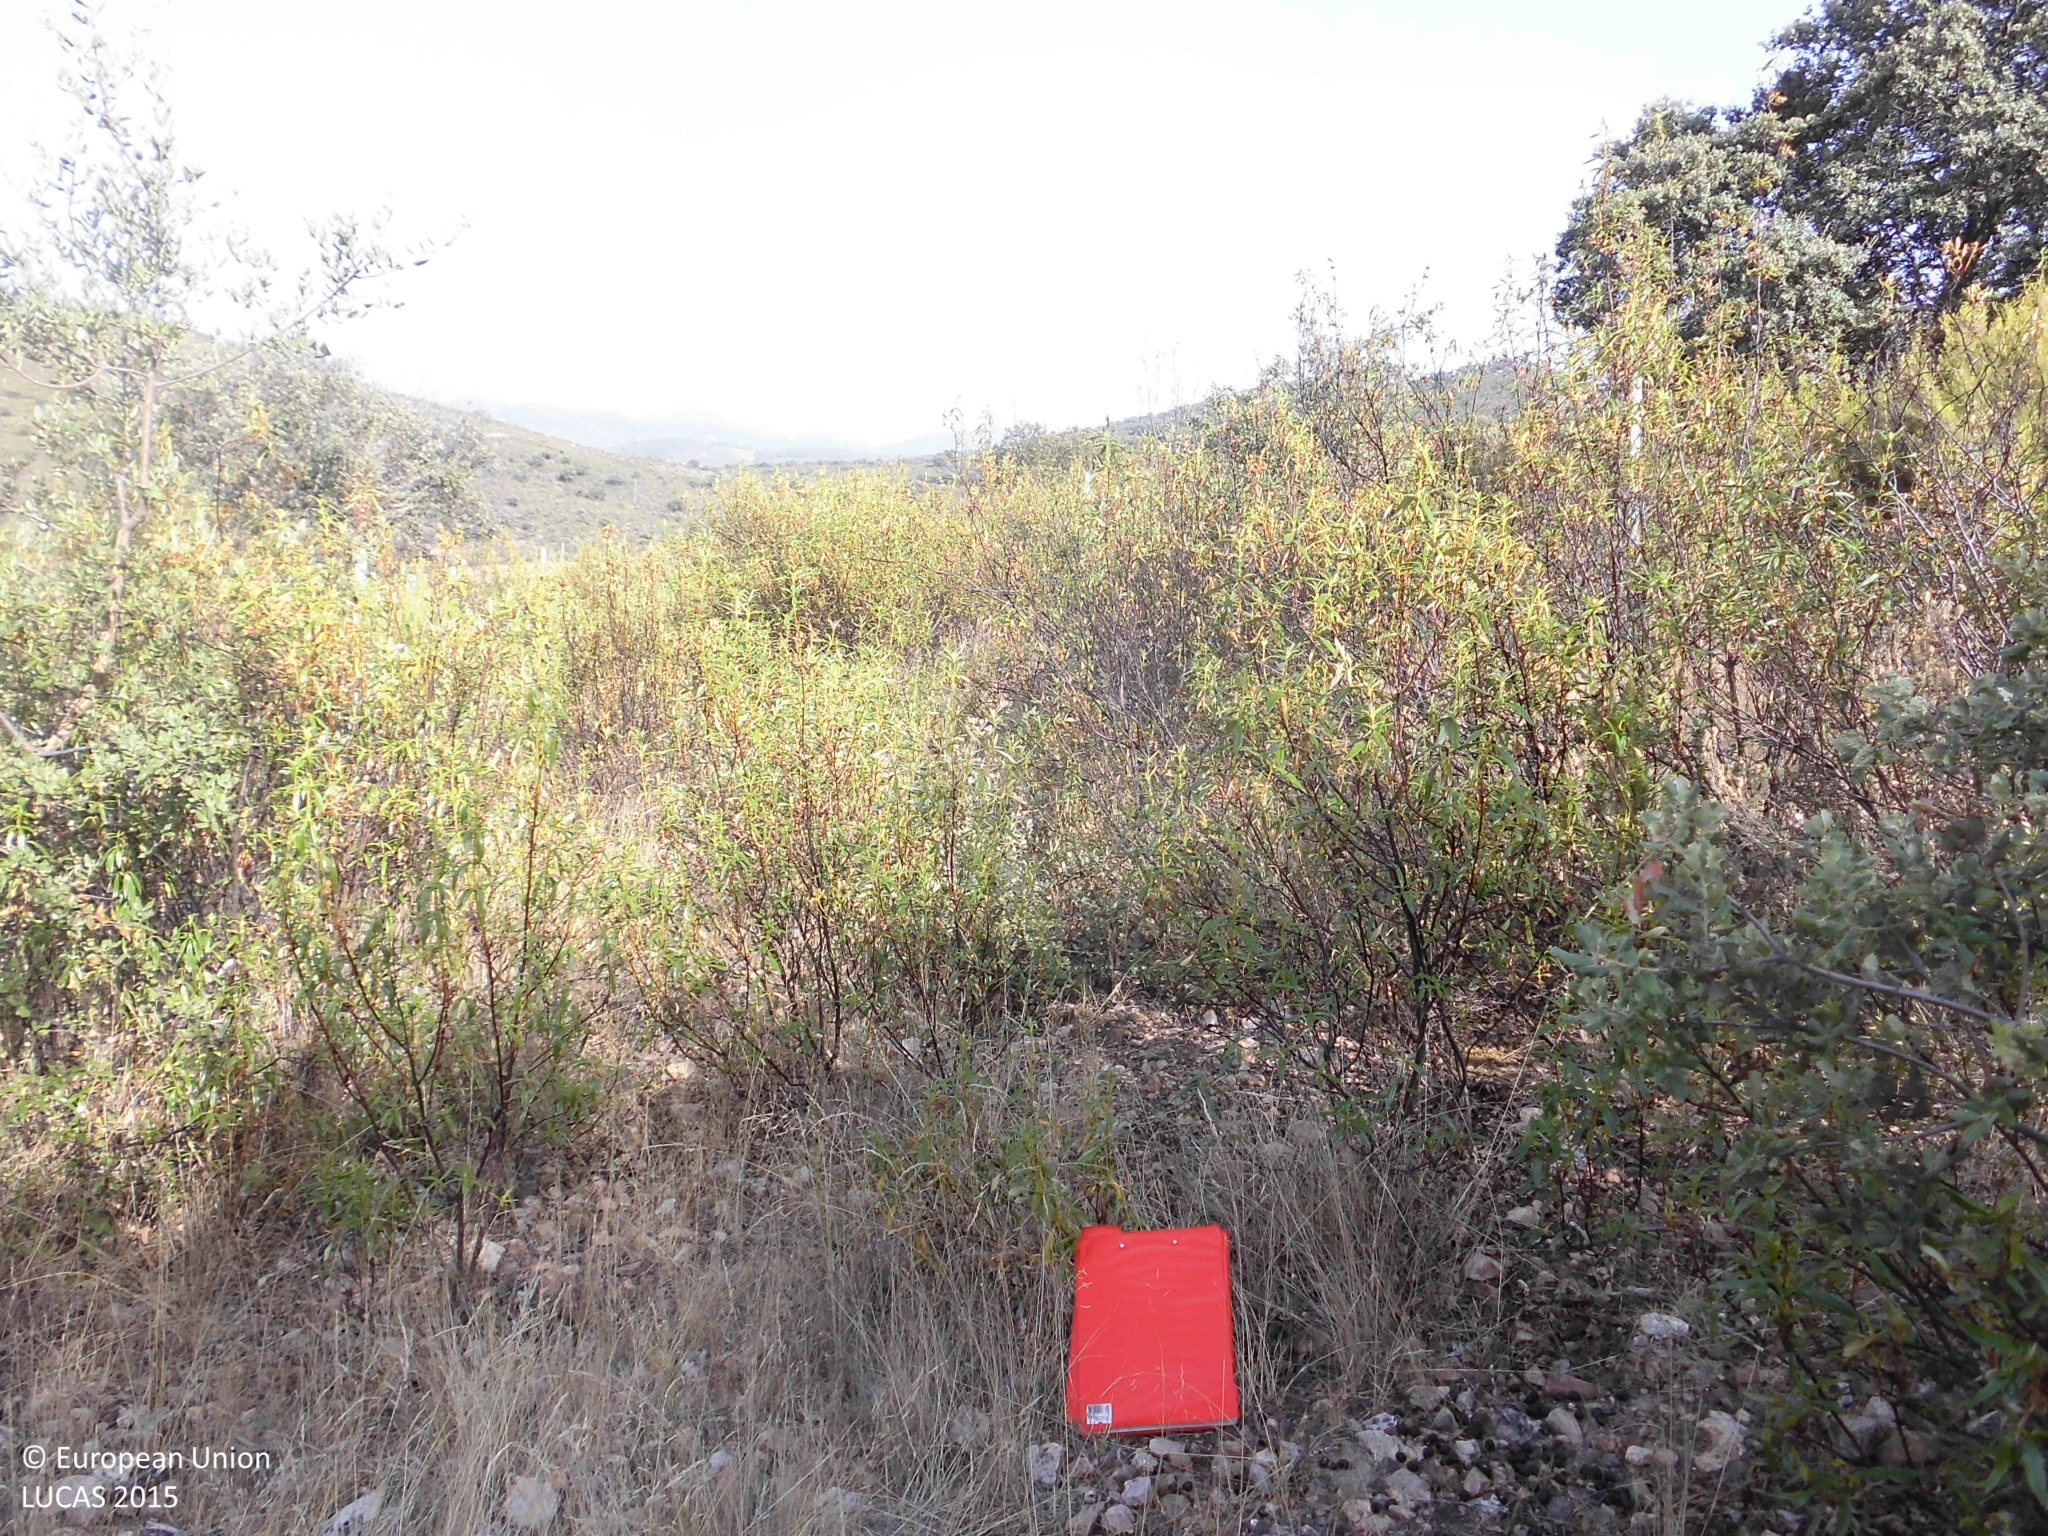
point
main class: Shrubland
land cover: Shrubland with sparse tree cover
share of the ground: > 75 %
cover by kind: shrubs 90 %, broadleaved forest trees 5 %, herbaceous plants 5 %
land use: Forestry
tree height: > 5 m
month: July
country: ES
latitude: 39.6520
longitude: -5.6150
